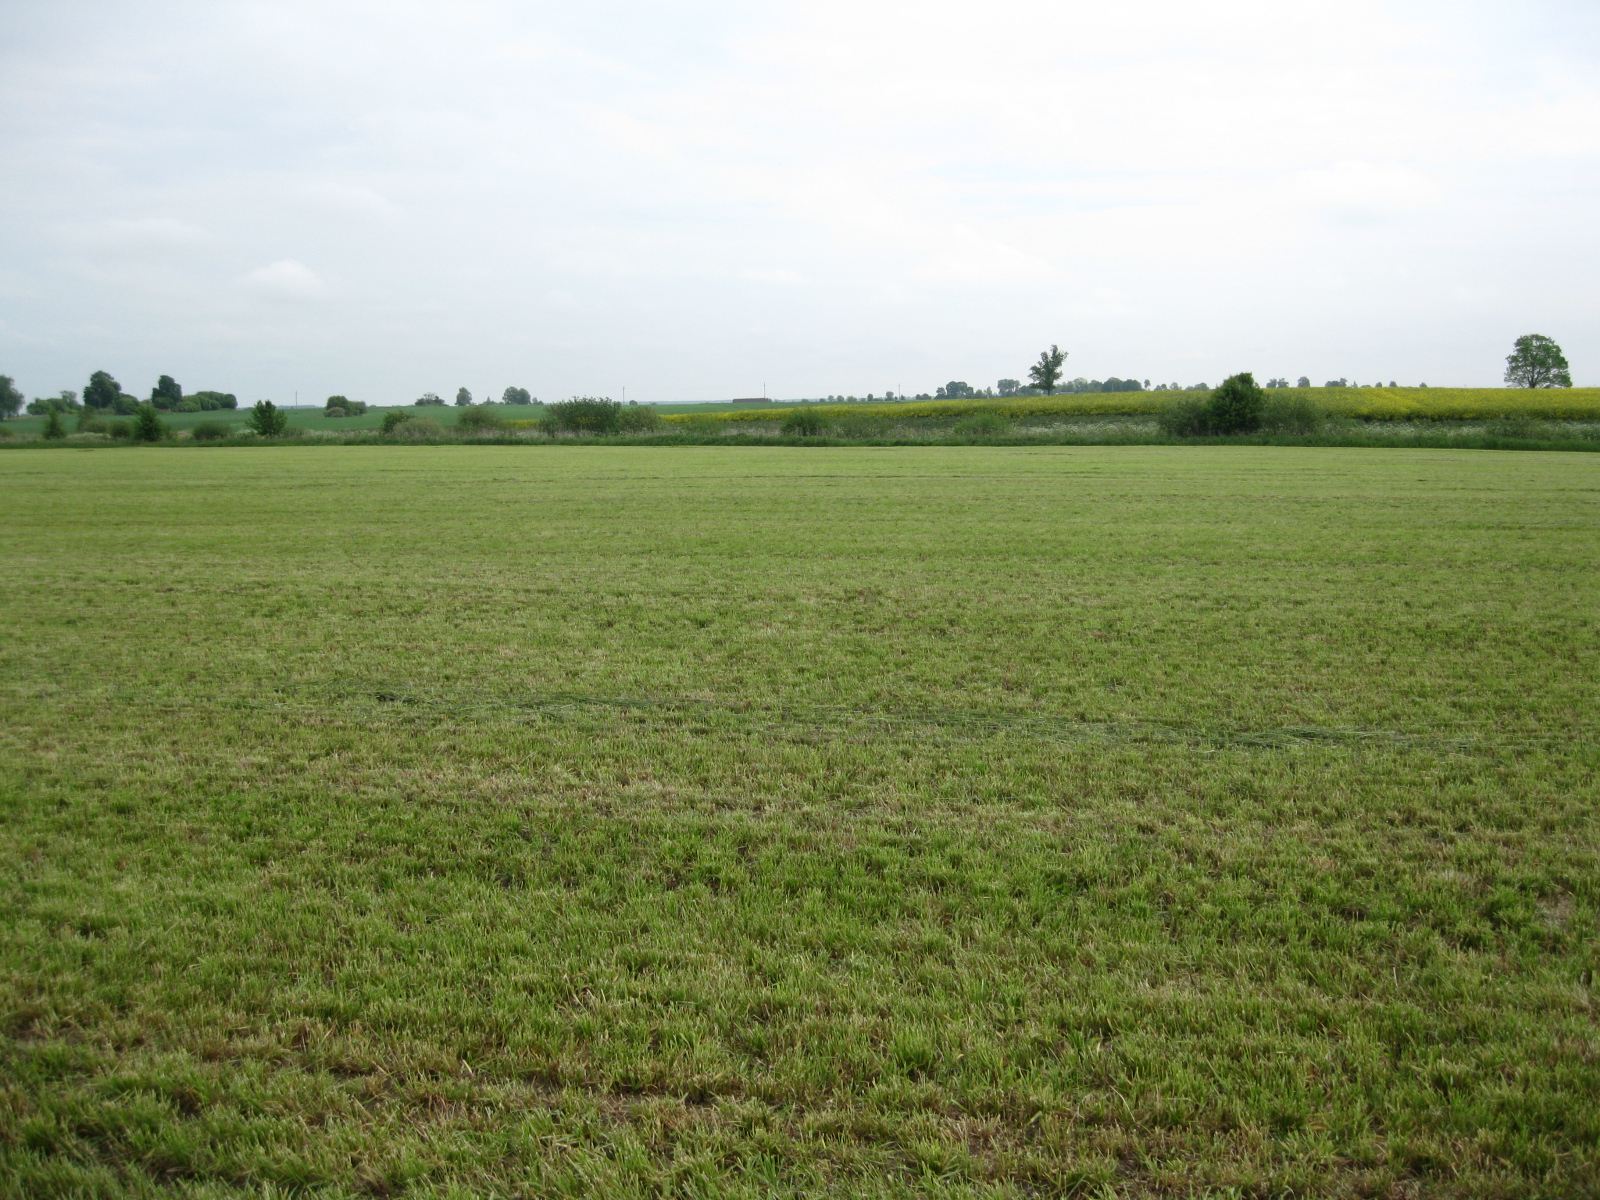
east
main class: Cropland
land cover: Temporary grasslands
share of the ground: > 75 %
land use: Agriculture (excluding fallow land and kitchen gardens)
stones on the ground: < 10 %
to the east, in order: Temporary grasslands; Grassland with sparse tree/shrub cover; Abandoned hedges; Ditches and canals; Spontaneously vegetated surfaces; Rape and turnip rape
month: June
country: LT
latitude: 55.9485
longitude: 24.1341
